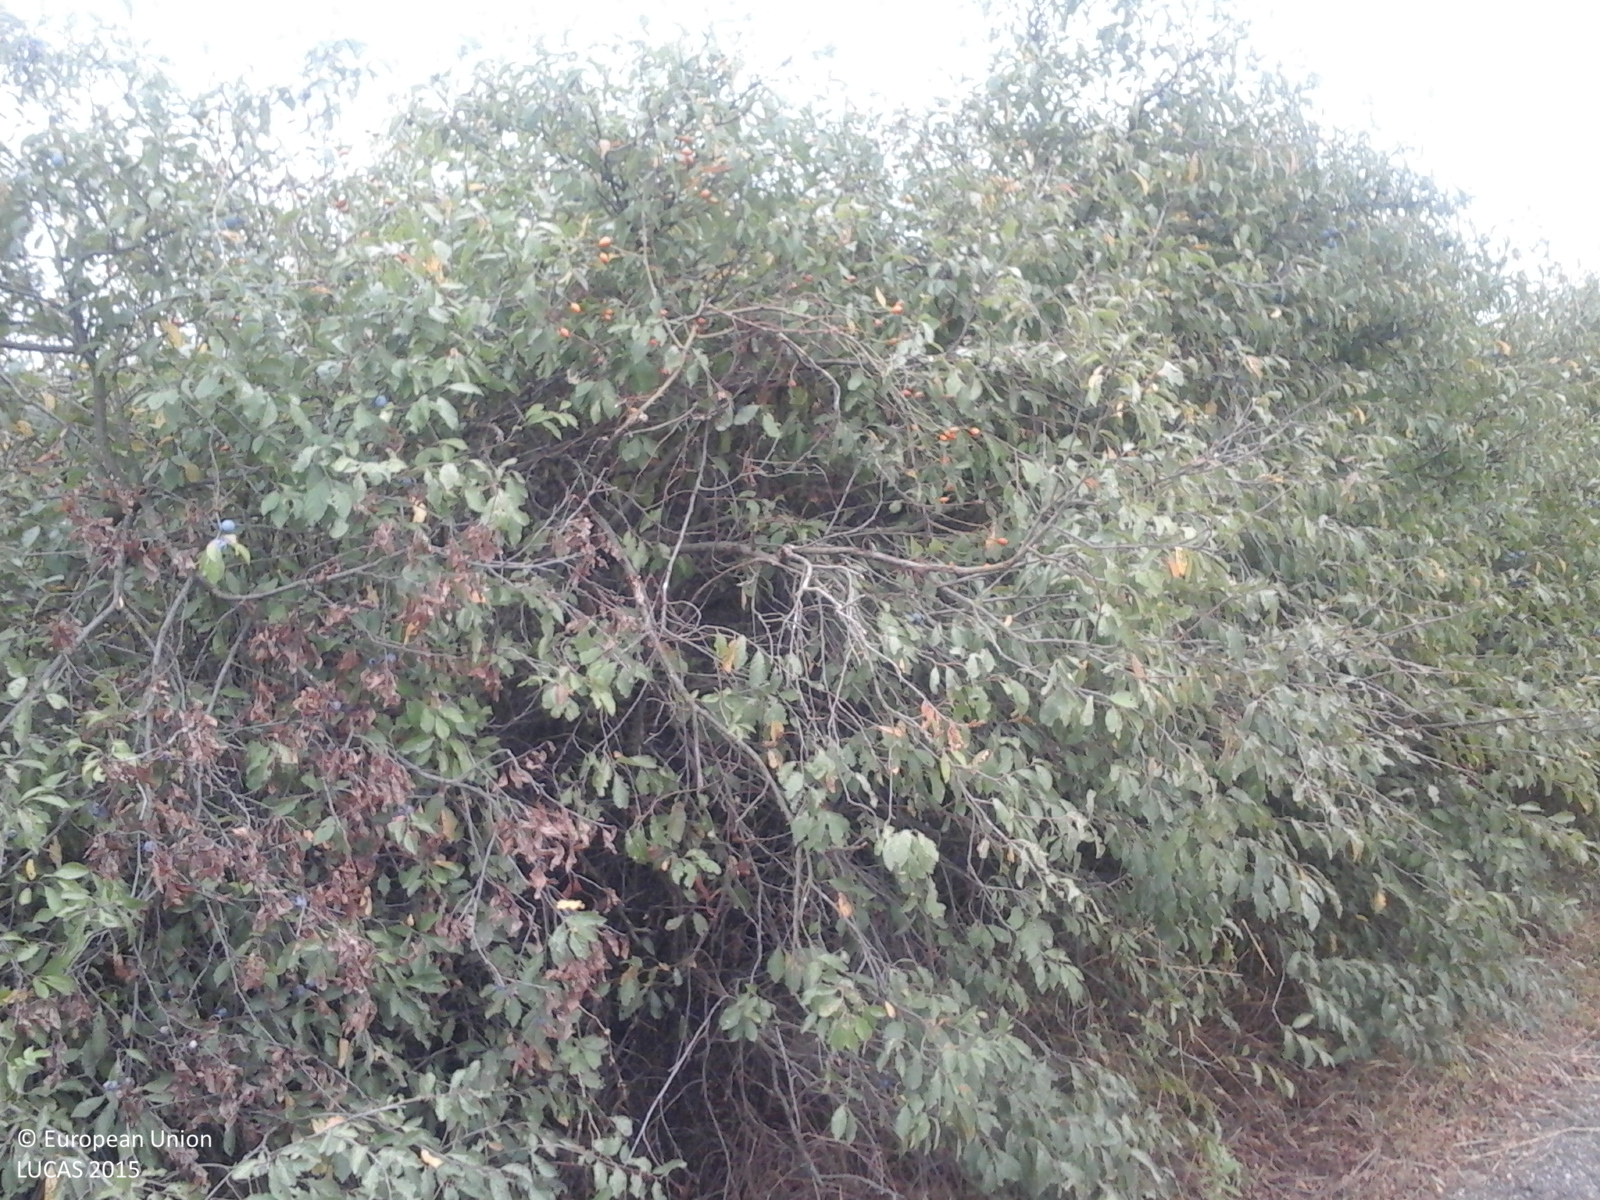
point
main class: Shrubland
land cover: Shrubland without tree cover
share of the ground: > 75 %
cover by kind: shrubs 100 %
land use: Semi-natural and natural areas not in use
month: September
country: RO
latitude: 47.6531
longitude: 22.6687
